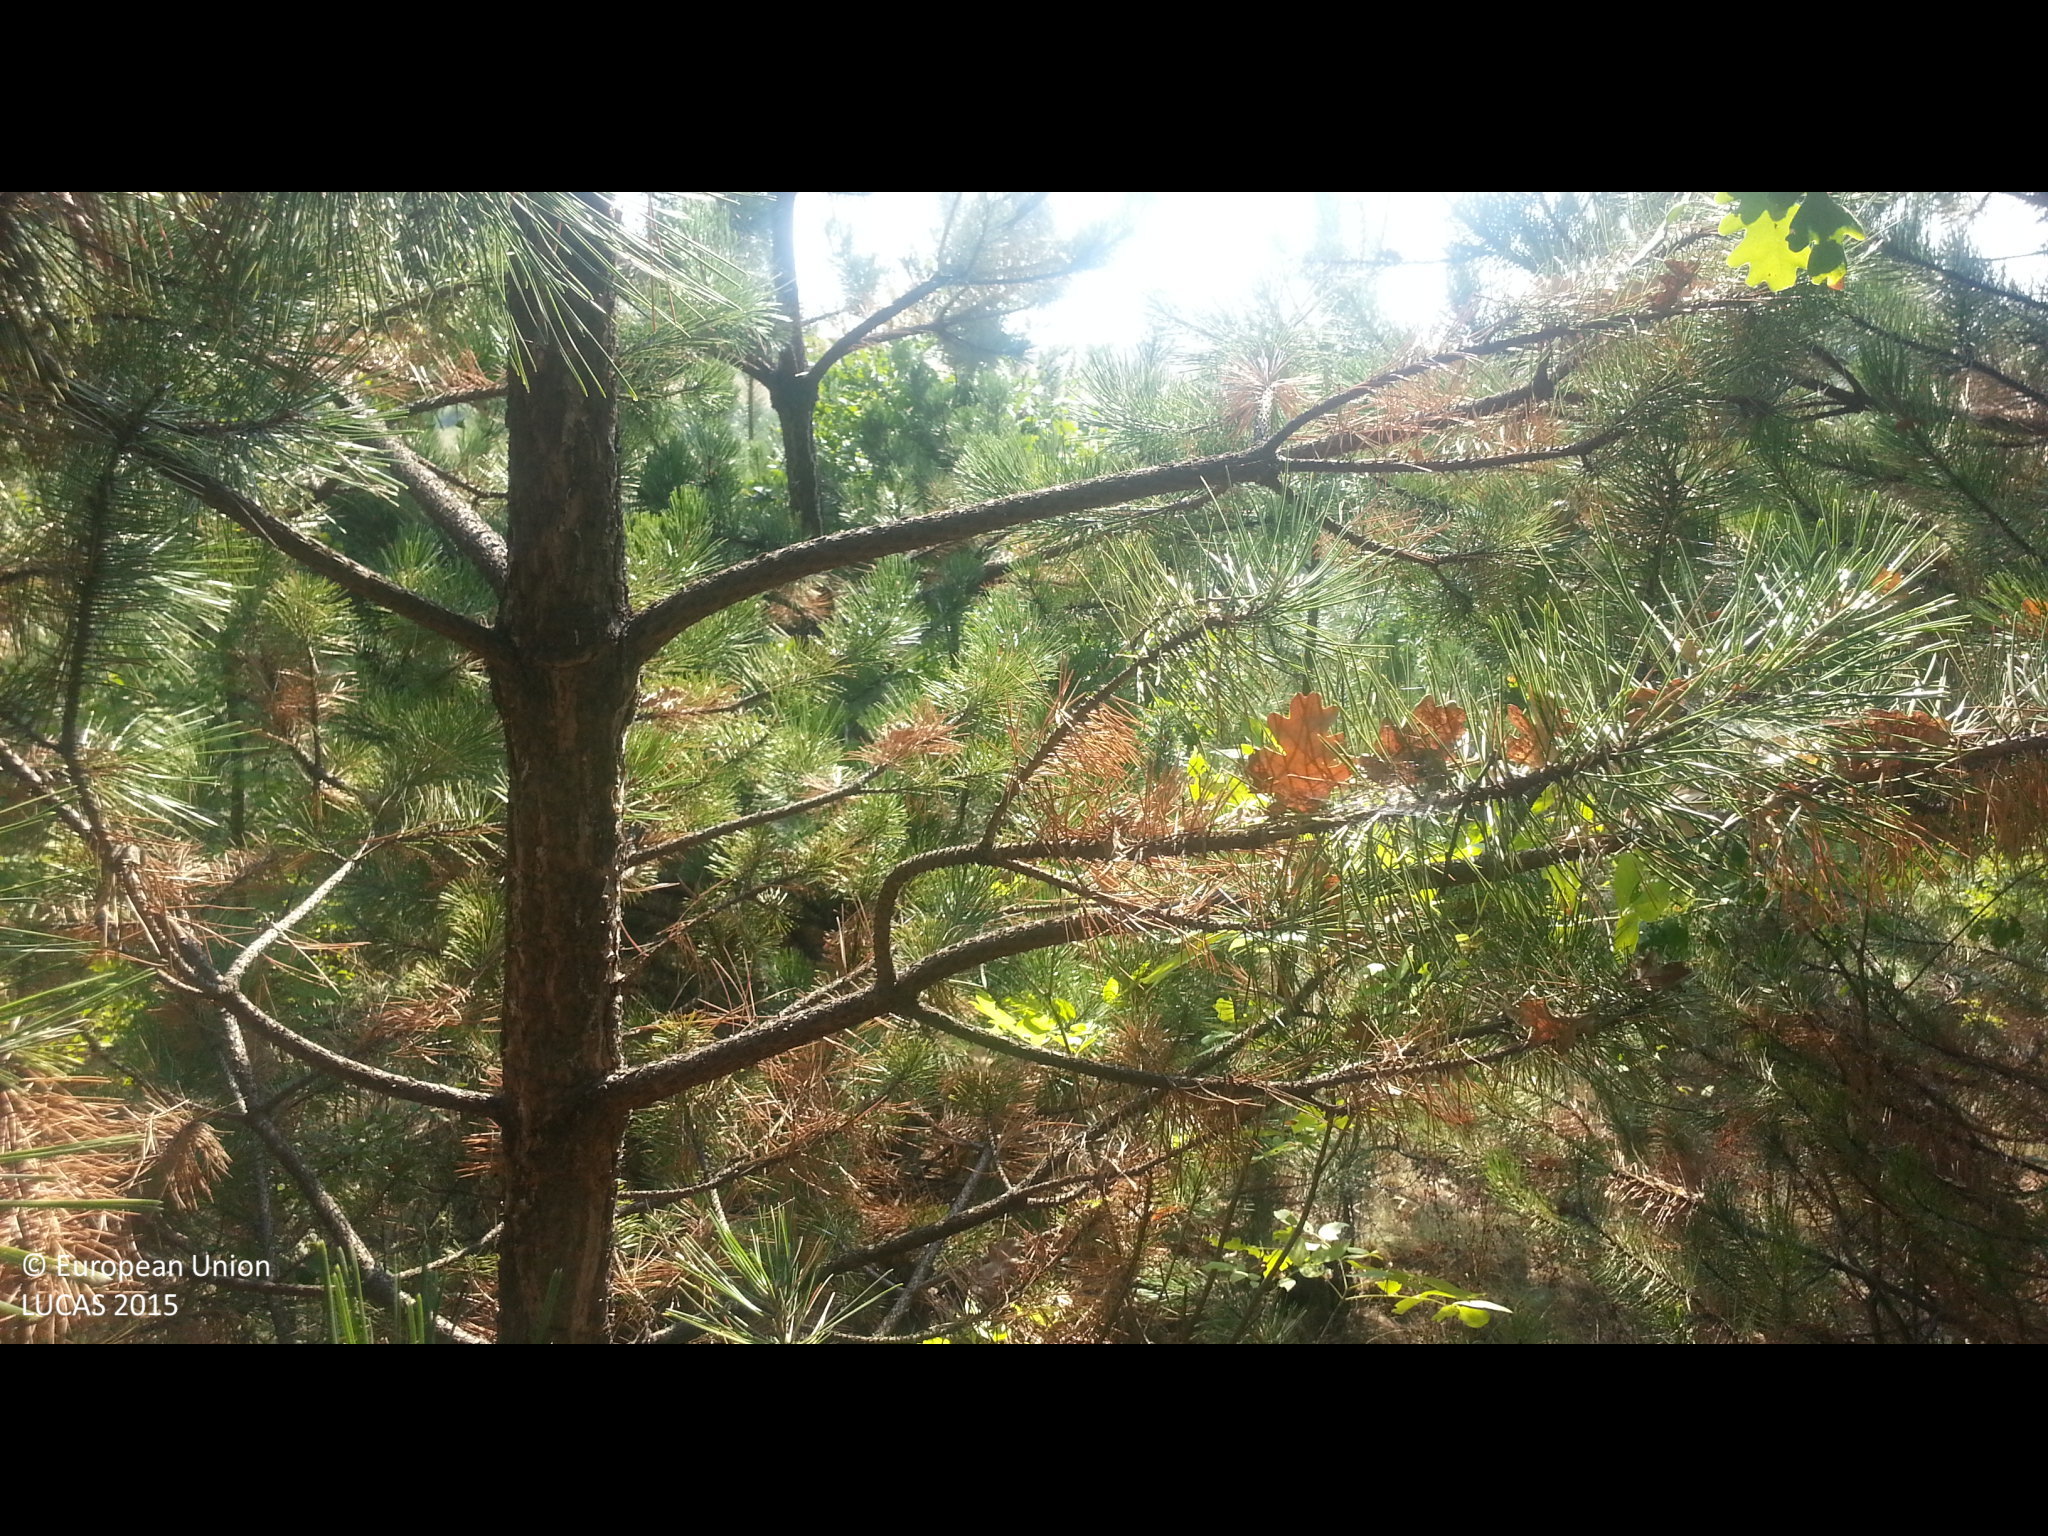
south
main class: Woodland
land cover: Other mixed woodland
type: hemiboreal forest and nemoral coniferous forest and mixed broadleaved-coniferous forest
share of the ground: > 75 %
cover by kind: coniferous forest trees 75 %, broadleaved forest trees 25 %
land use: Forestry
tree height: < 5 m
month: August
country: BG
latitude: 42.3680
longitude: 23.0814
